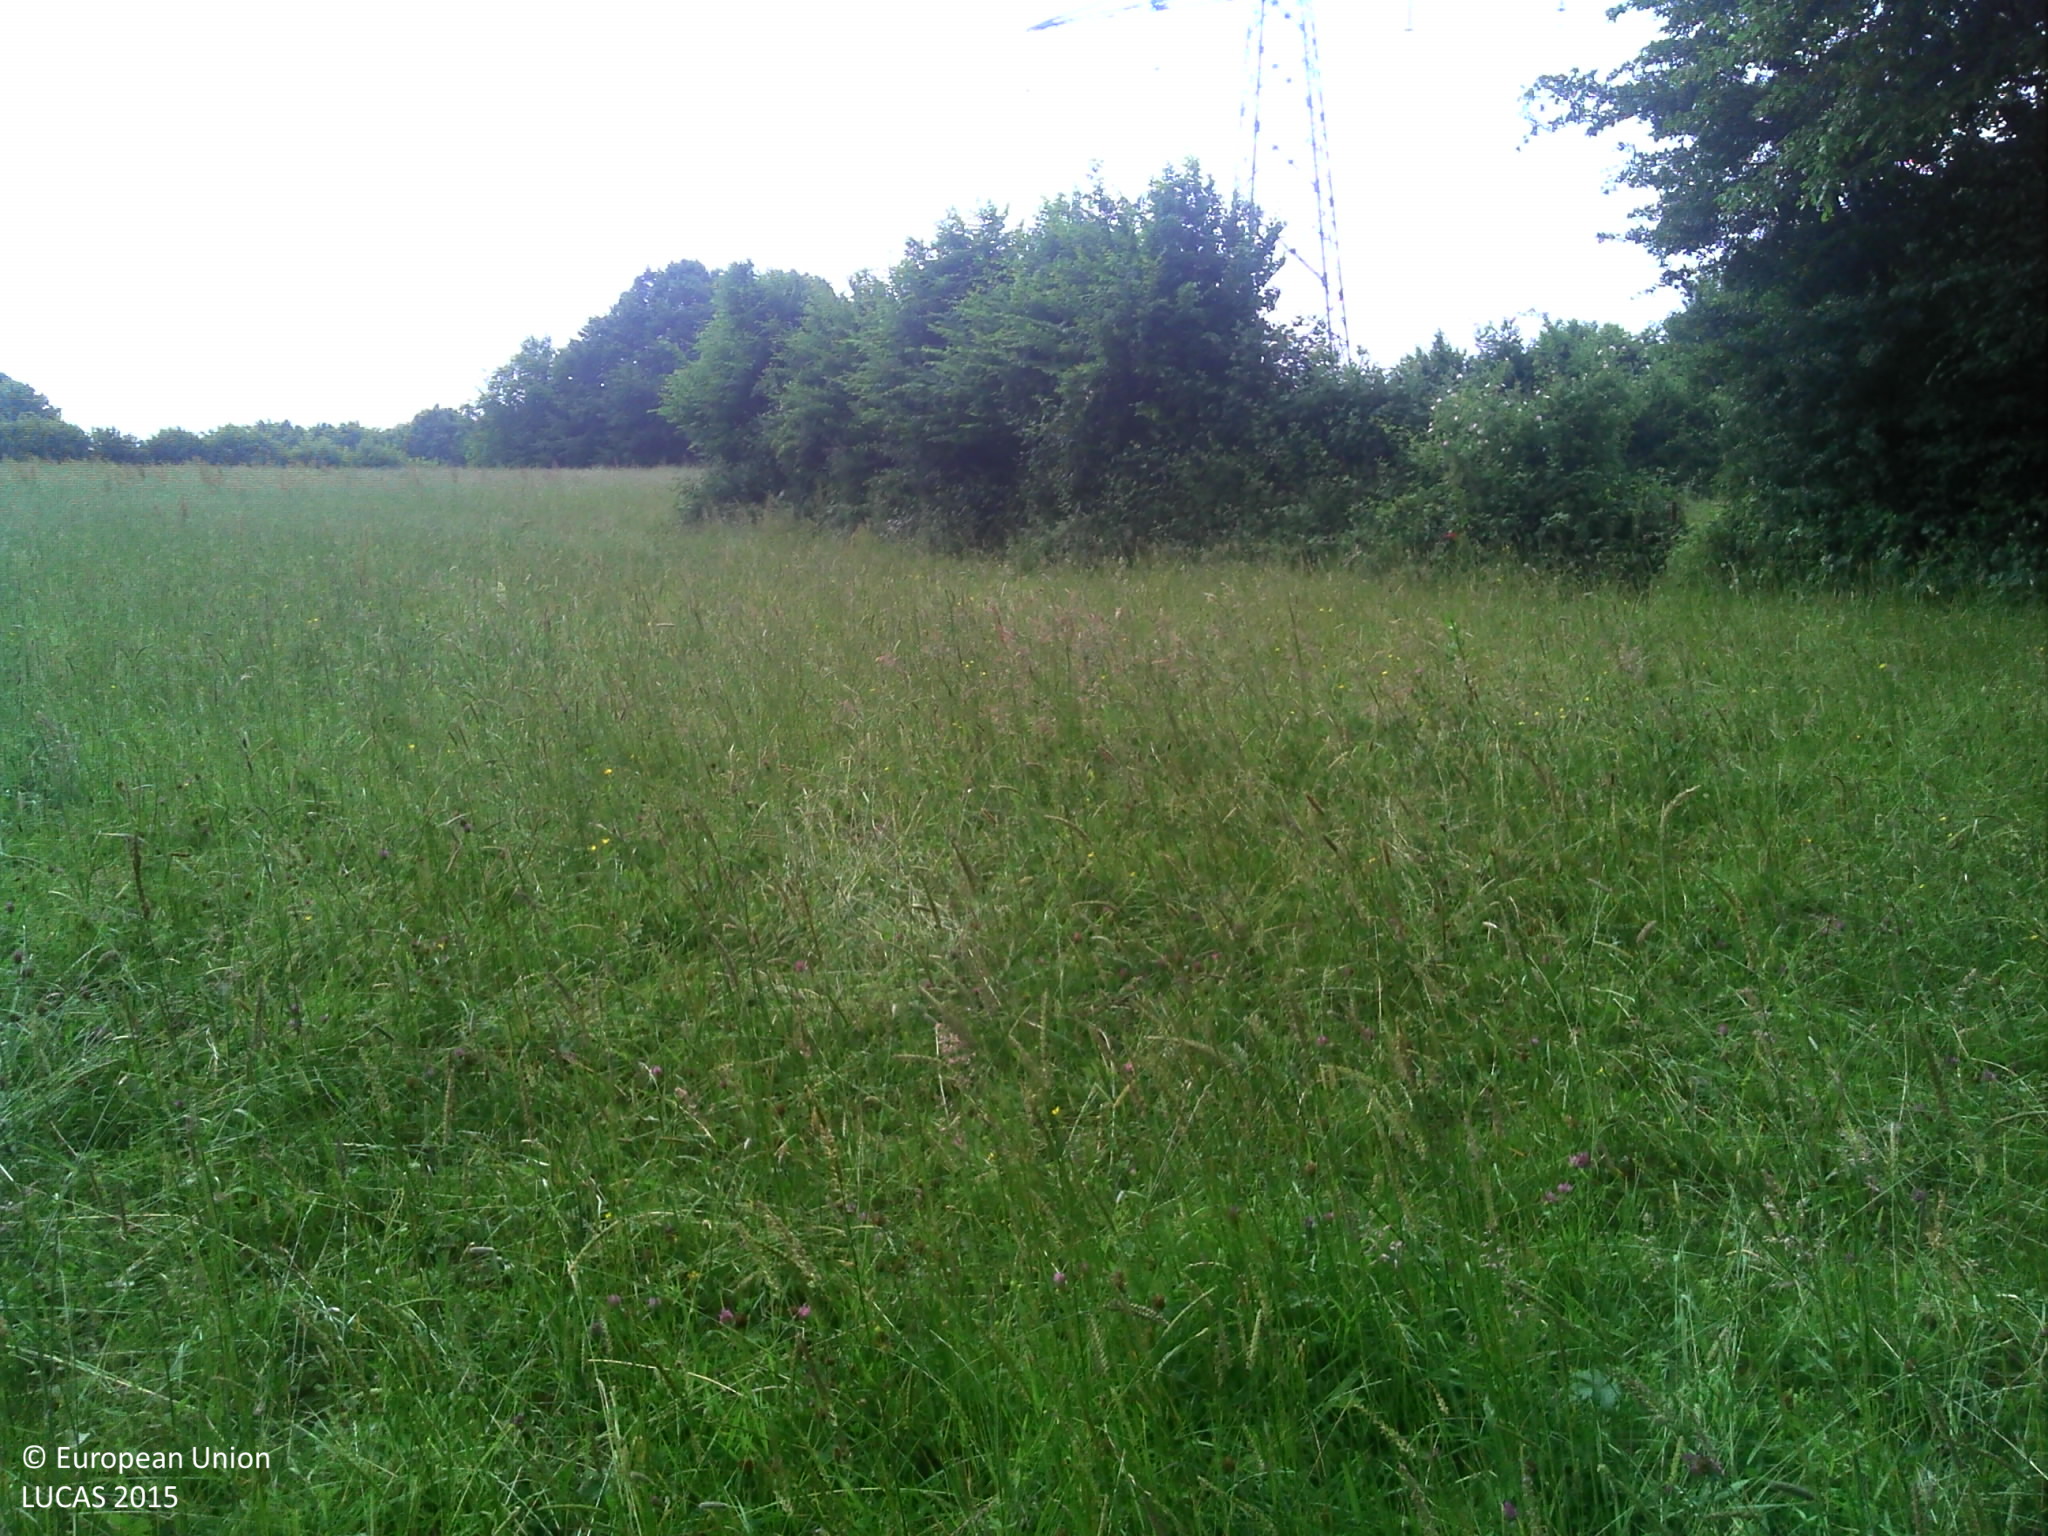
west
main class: Grassland
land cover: Grassland without tree/shrub cover
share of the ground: > 75 %
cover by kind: herbaceous plants 100 %
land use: Agriculture (excluding fallow land and kitchen gardens)
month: June
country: FR
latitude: 49.9176
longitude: 3.9918
